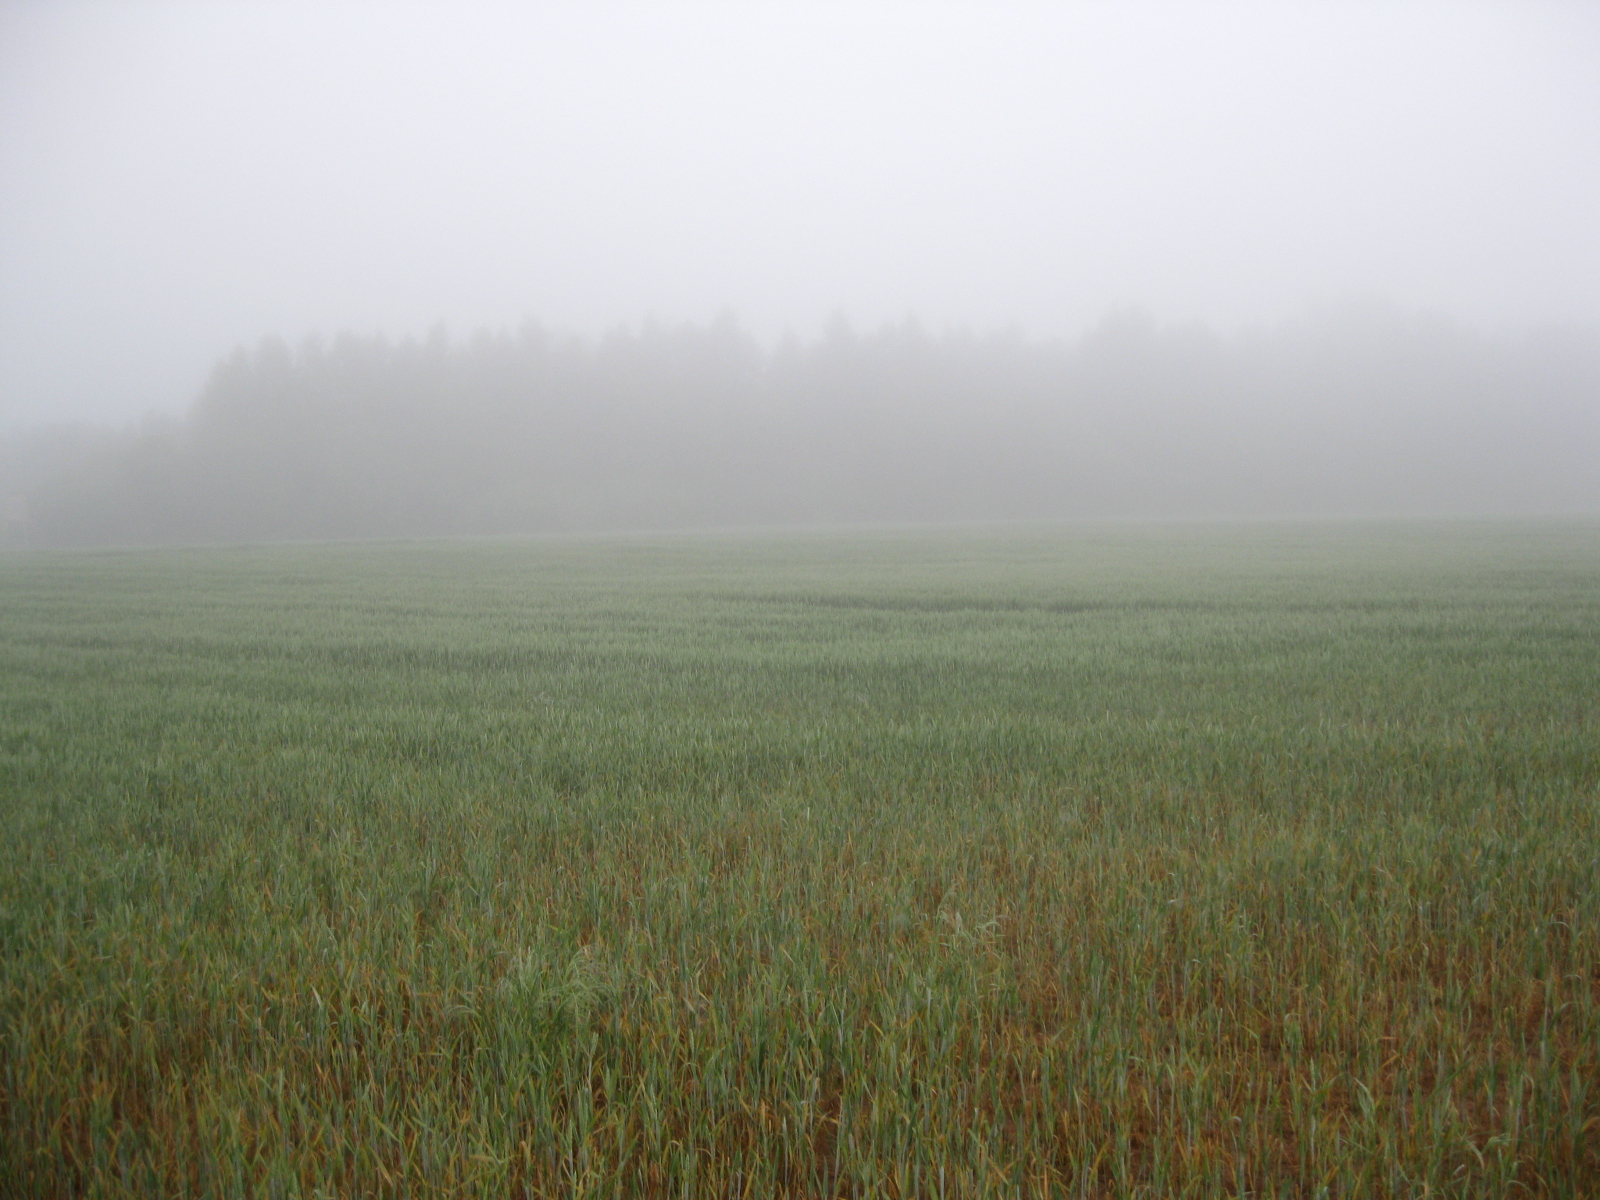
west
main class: Cropland
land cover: Common wheat
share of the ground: > 75 %
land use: Agriculture (excluding fallow land and kitchen gardens)
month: June
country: LT
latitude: 55.4353
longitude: 23.9814
